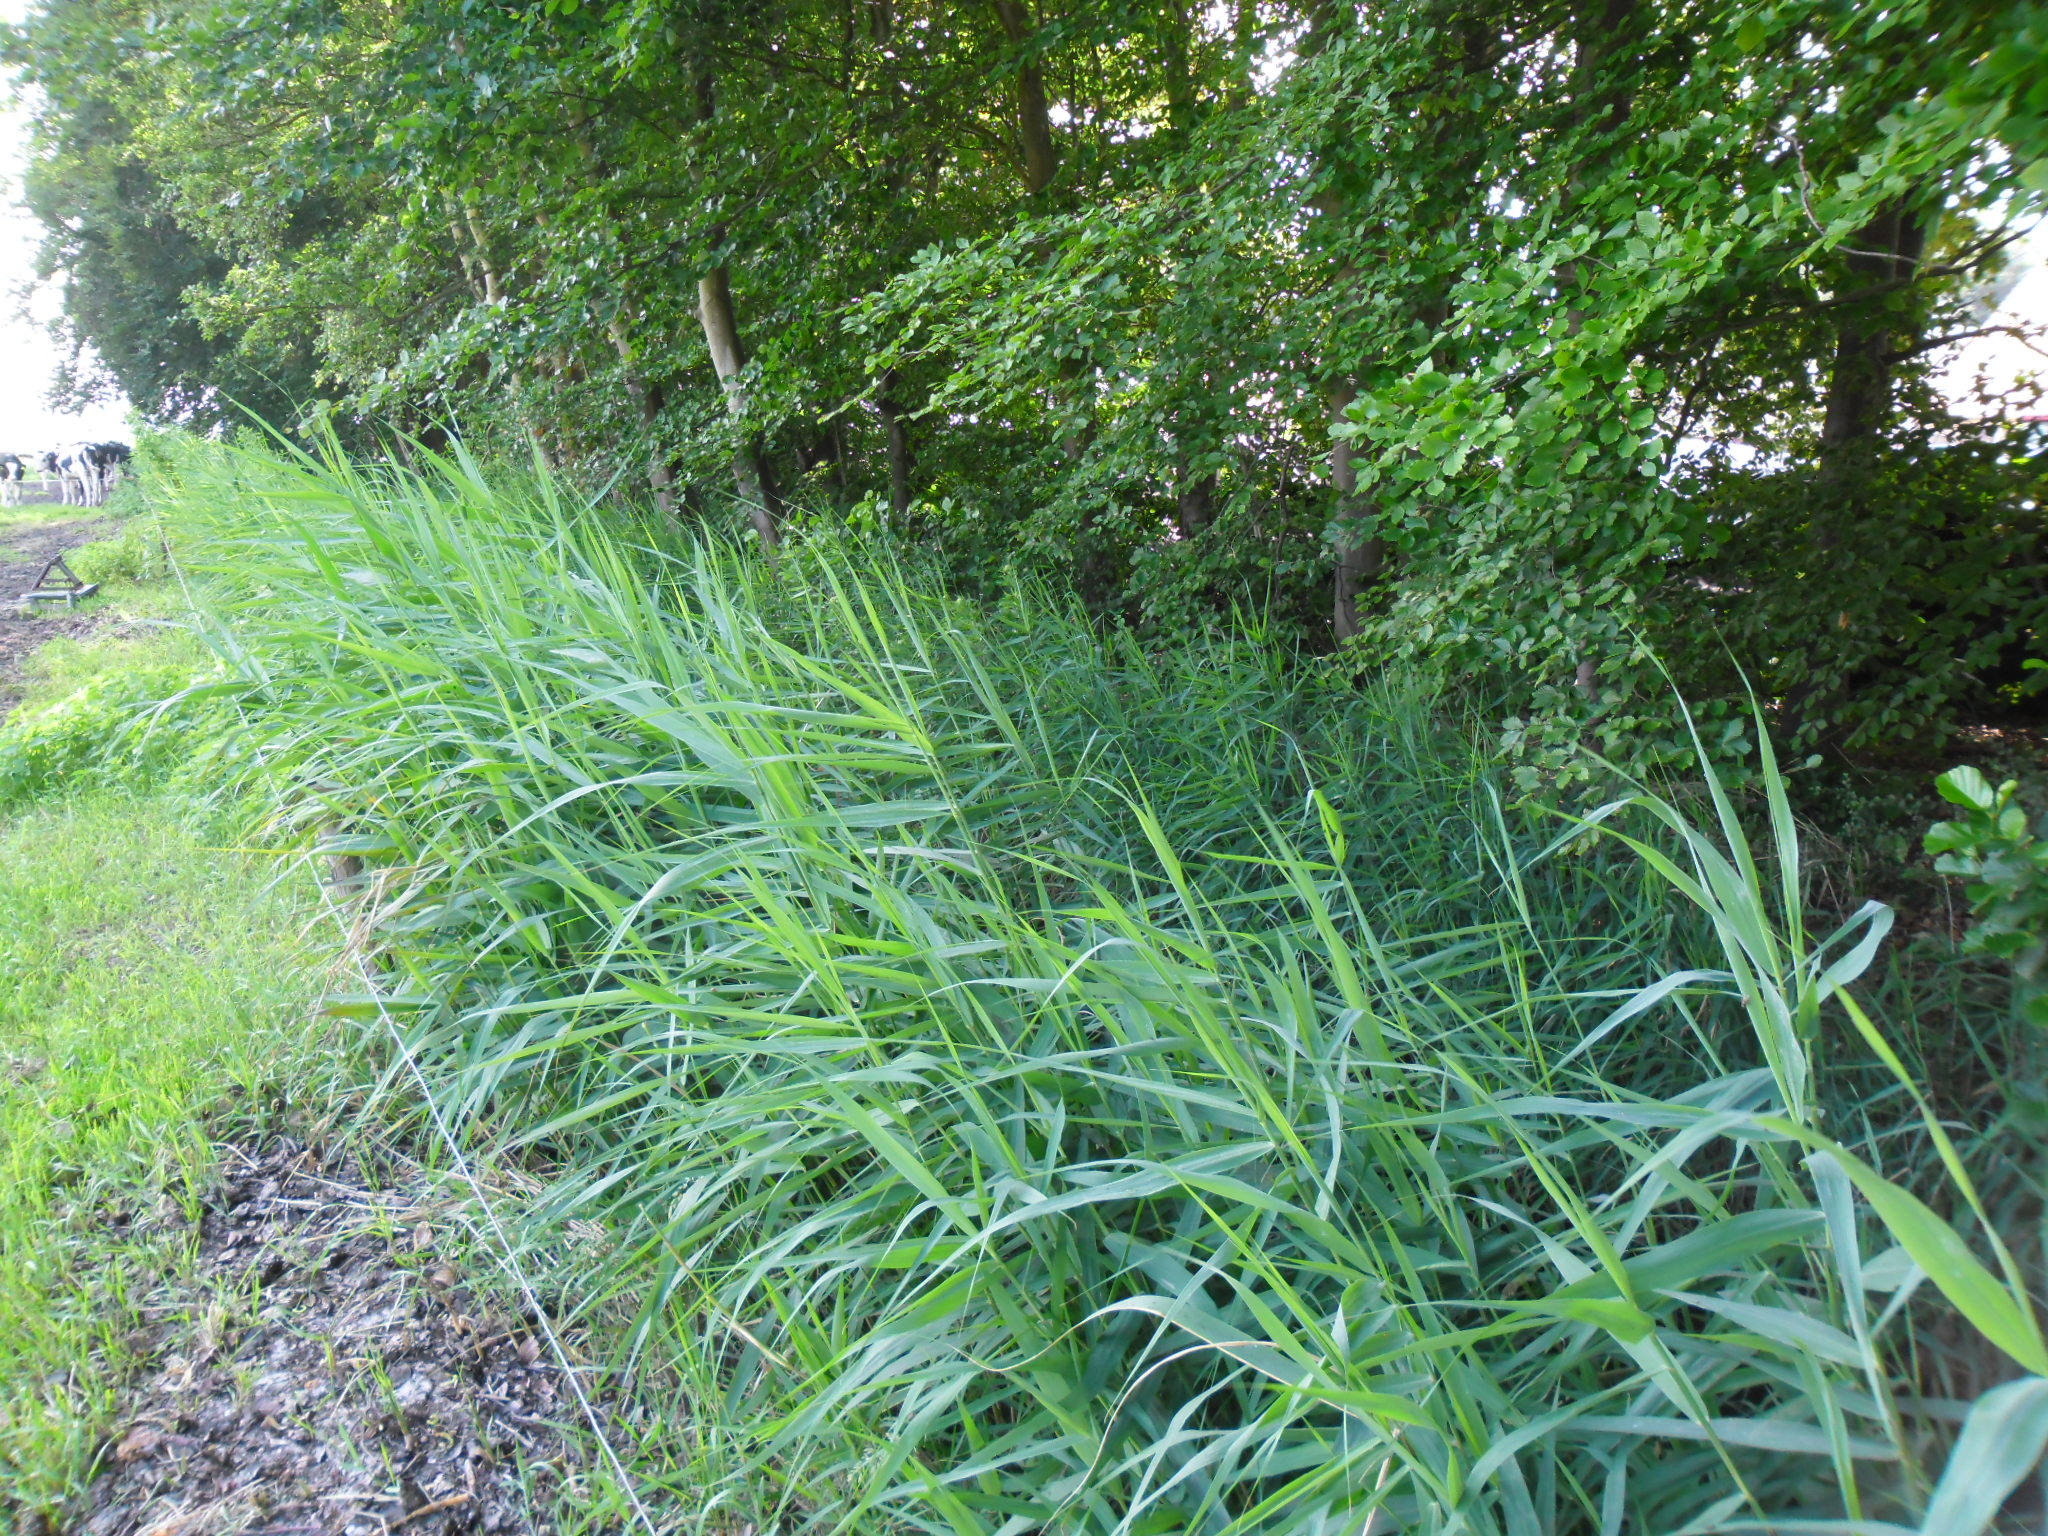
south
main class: Grassland
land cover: Grassland without tree/shrub cover
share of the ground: > 75 %
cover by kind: herbaceous plants 100 %
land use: Agriculture (excluding fallow land and kitchen gardens)
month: July
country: NL
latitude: 52.6753
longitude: 5.6358
